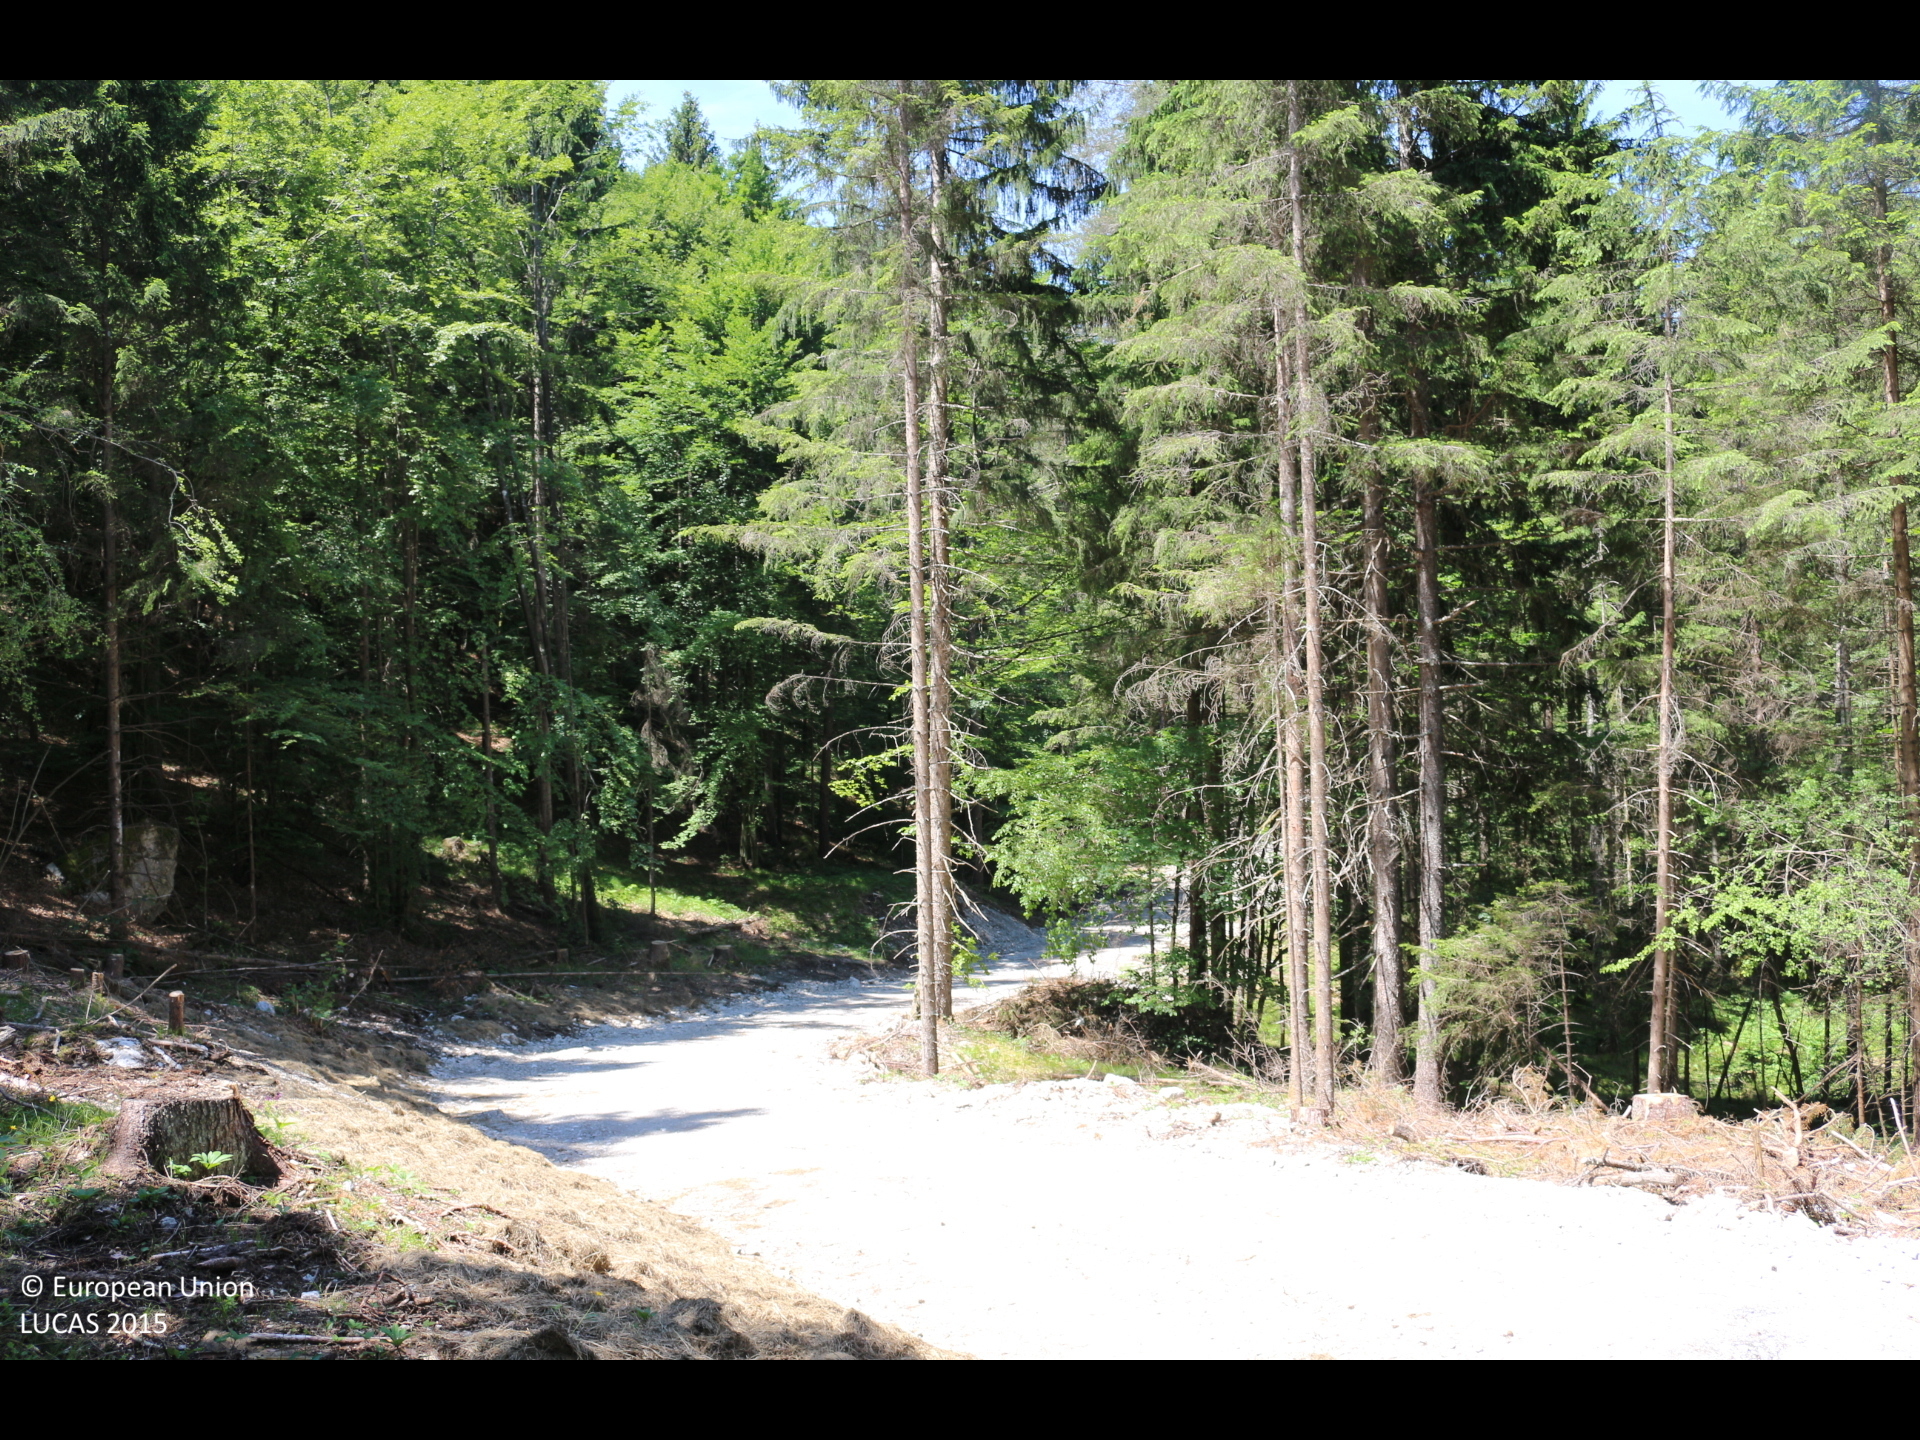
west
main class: Woodland
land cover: Spruce dominated mixed woodland
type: mountainous beech forest
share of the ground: > 75 %
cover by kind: coniferous forest trees 60 %, broadleaved forest trees 40 %
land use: Forestry
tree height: > 5 m
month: May
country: AT
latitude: 46.5260
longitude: 14.0776
